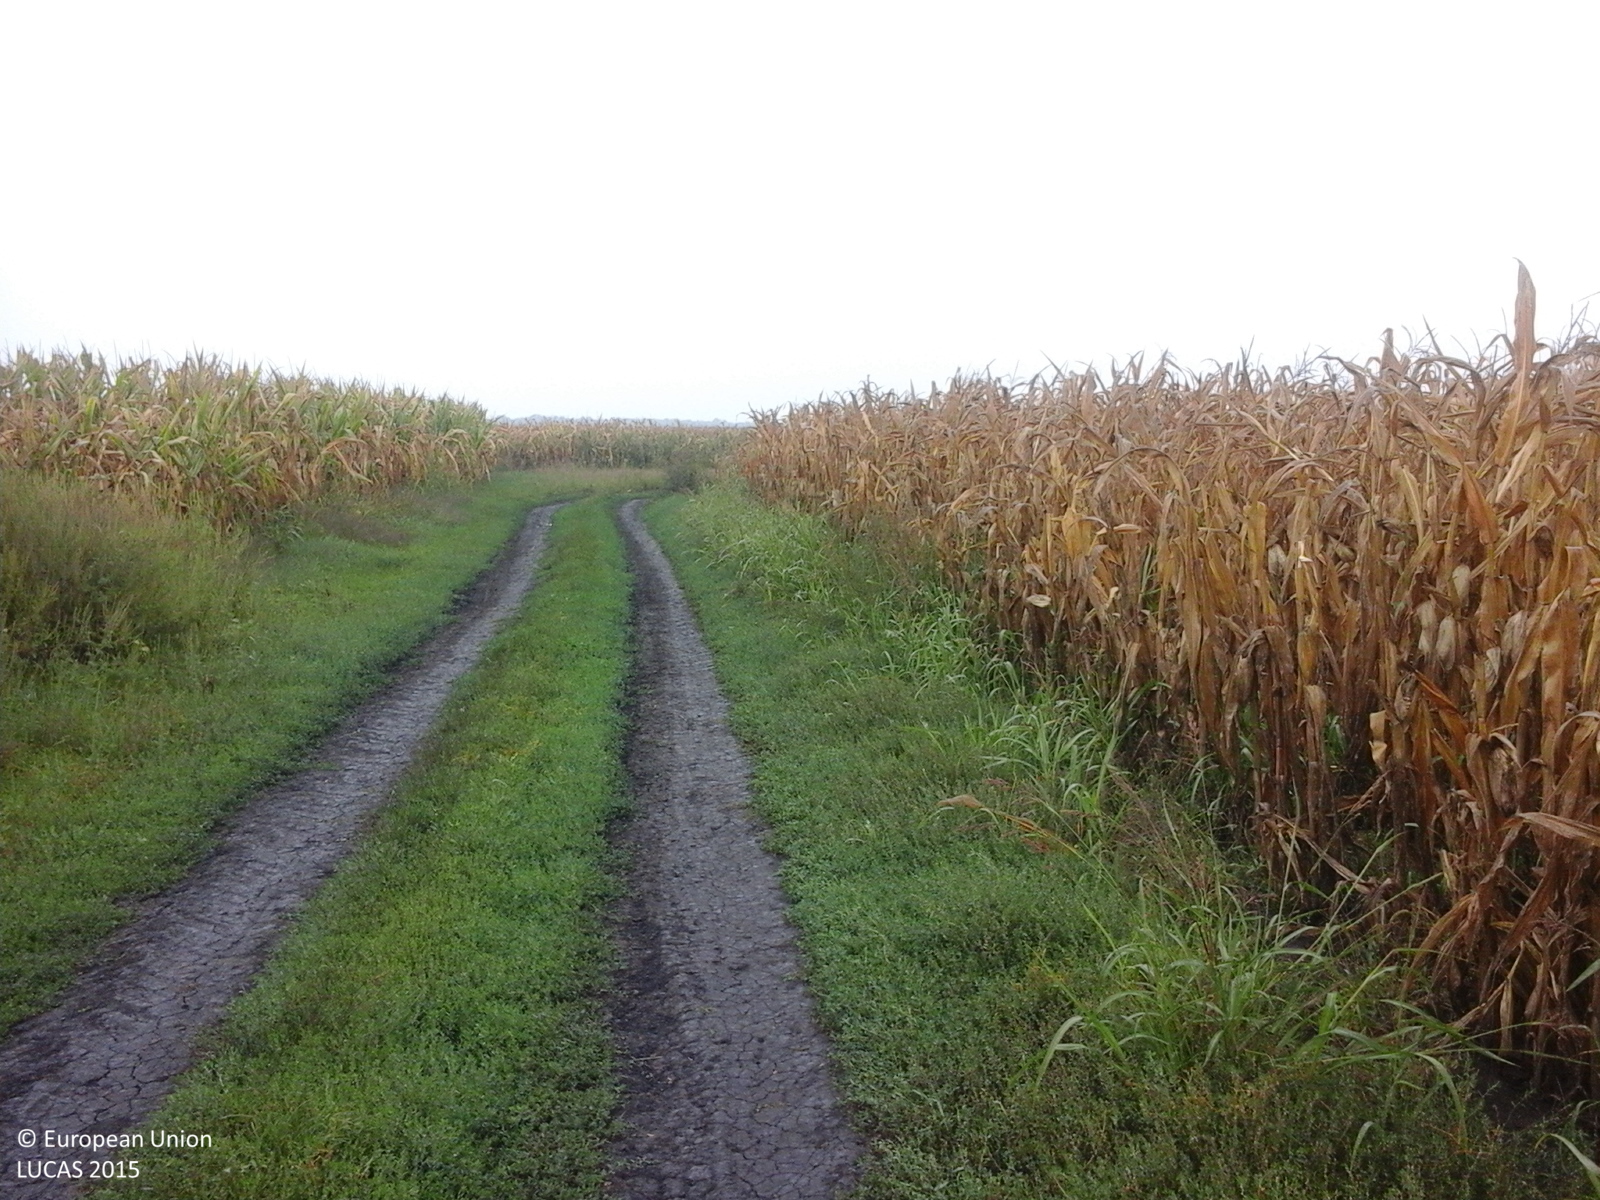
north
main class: Cropland
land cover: Maize
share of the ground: > 75 %
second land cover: Spontaneously vegetated surfaces
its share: > 75 %
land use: Agriculture (excluding fallow land and kitchen gardens)
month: September
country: RO
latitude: 47.4090
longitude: 22.0969
